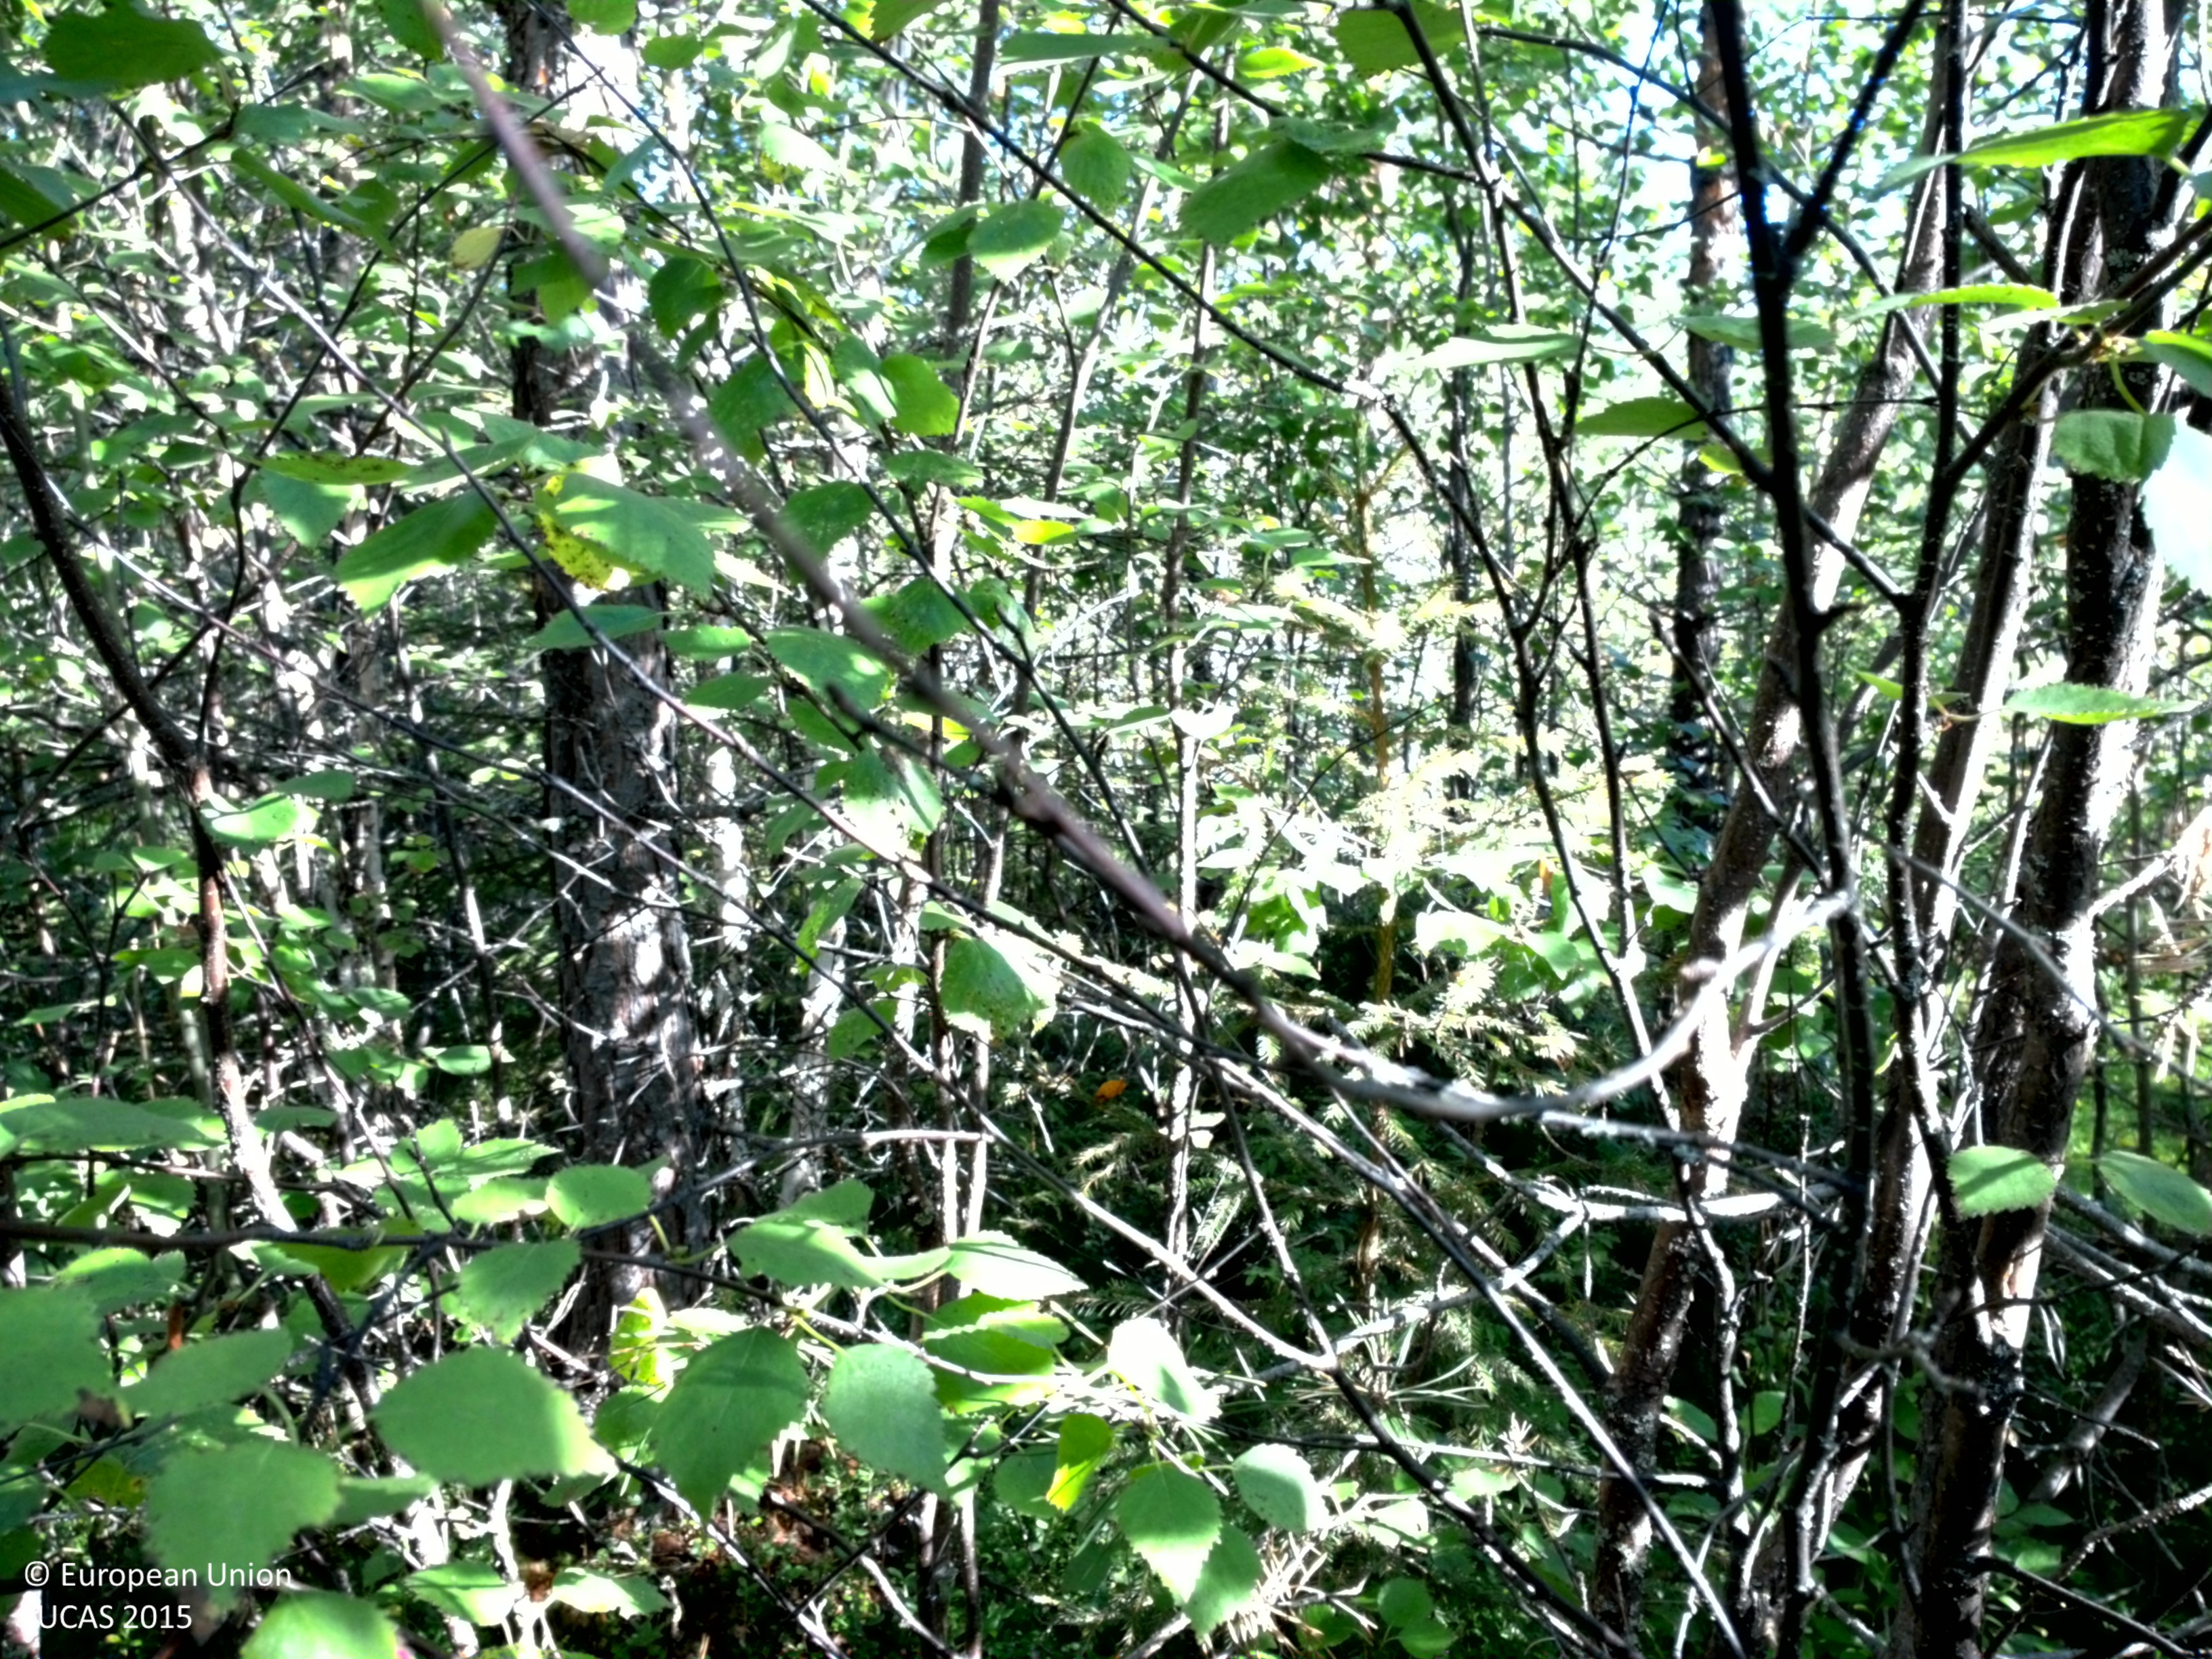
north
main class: Woodland
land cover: Pine dominated mixed woodland
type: boreal forest
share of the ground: 50 - 75 %
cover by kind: broadleaved forest trees 35 %, coniferous forest trees 30 %, shrubs 30 %, lichens and mosses 5 %
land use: Forestry
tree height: > 5 m
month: August
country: SE
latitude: 66.0636
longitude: 22.5462
